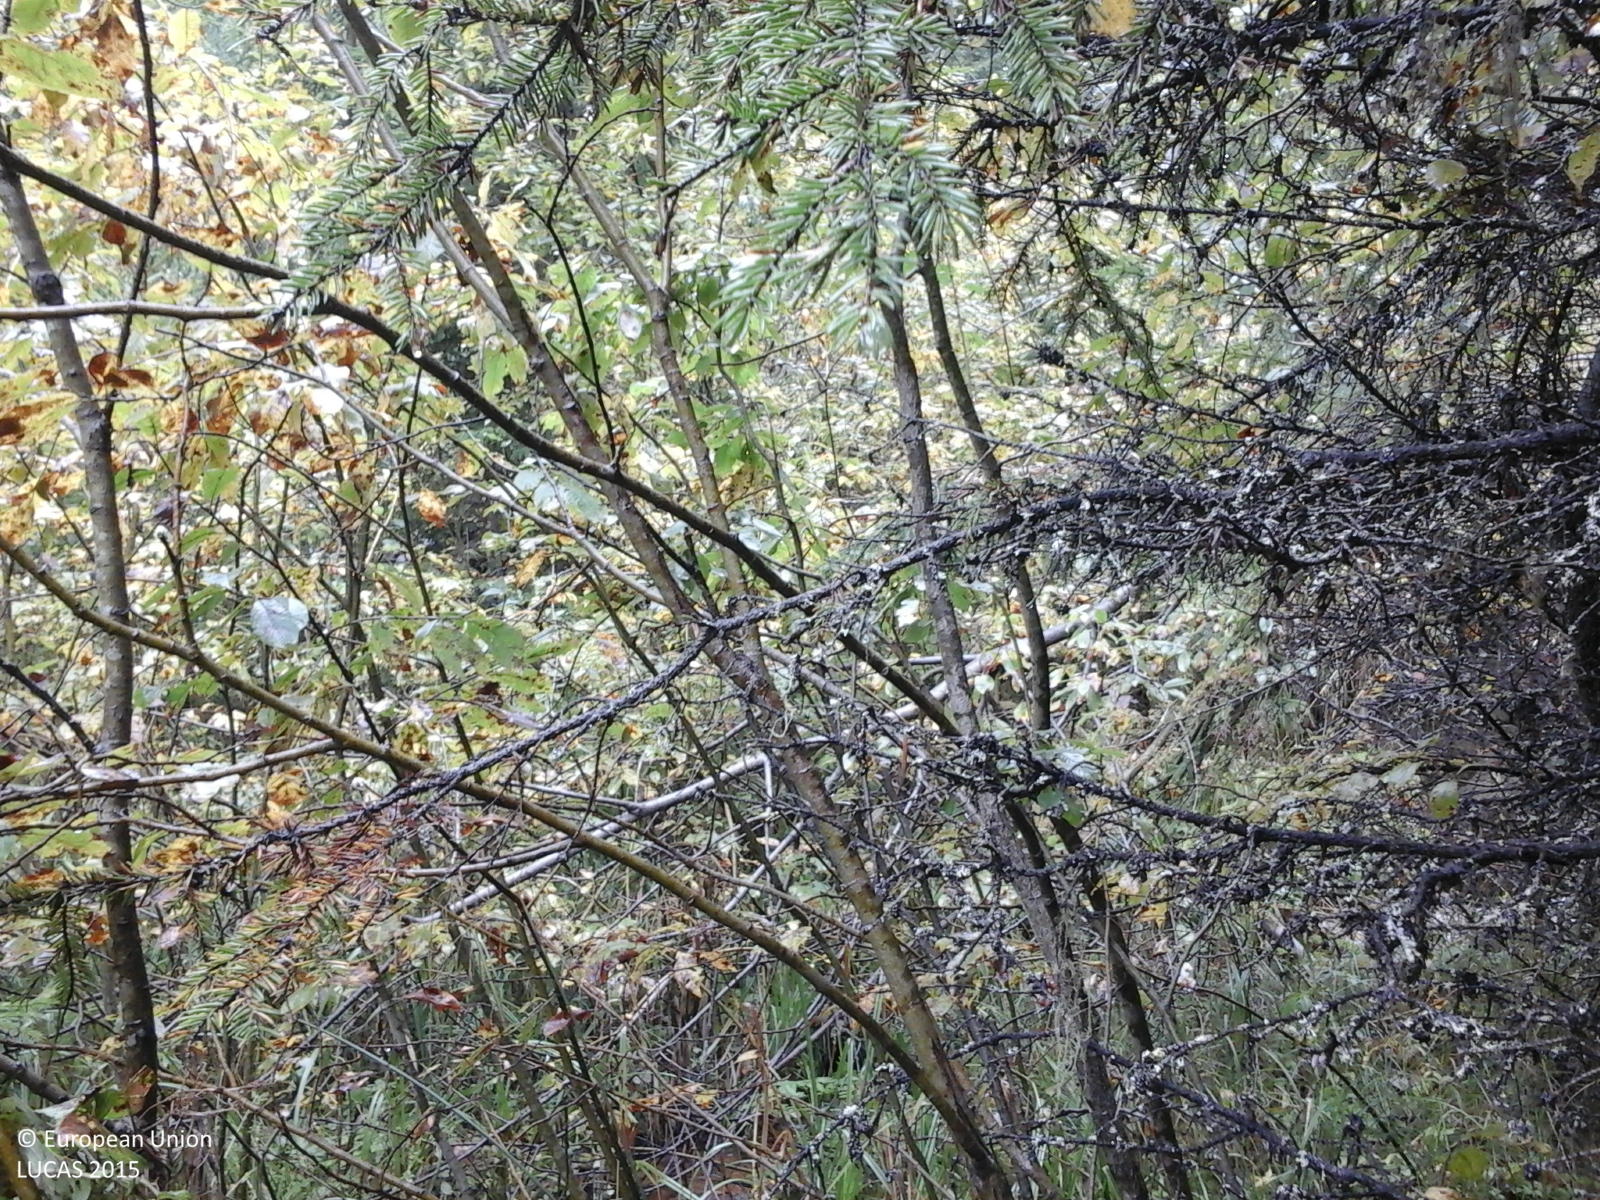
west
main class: Woodland
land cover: Spruce dominated coniferous woodland
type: alpine coniferous forest
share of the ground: > 75 %
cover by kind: coniferous forest trees 90 %, shrubs 5 %, herbaceous plants 5 %
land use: Forestry
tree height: > 5 m
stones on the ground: 10 - 25 %
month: September
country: RO
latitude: 45.5858
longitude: 23.6112
